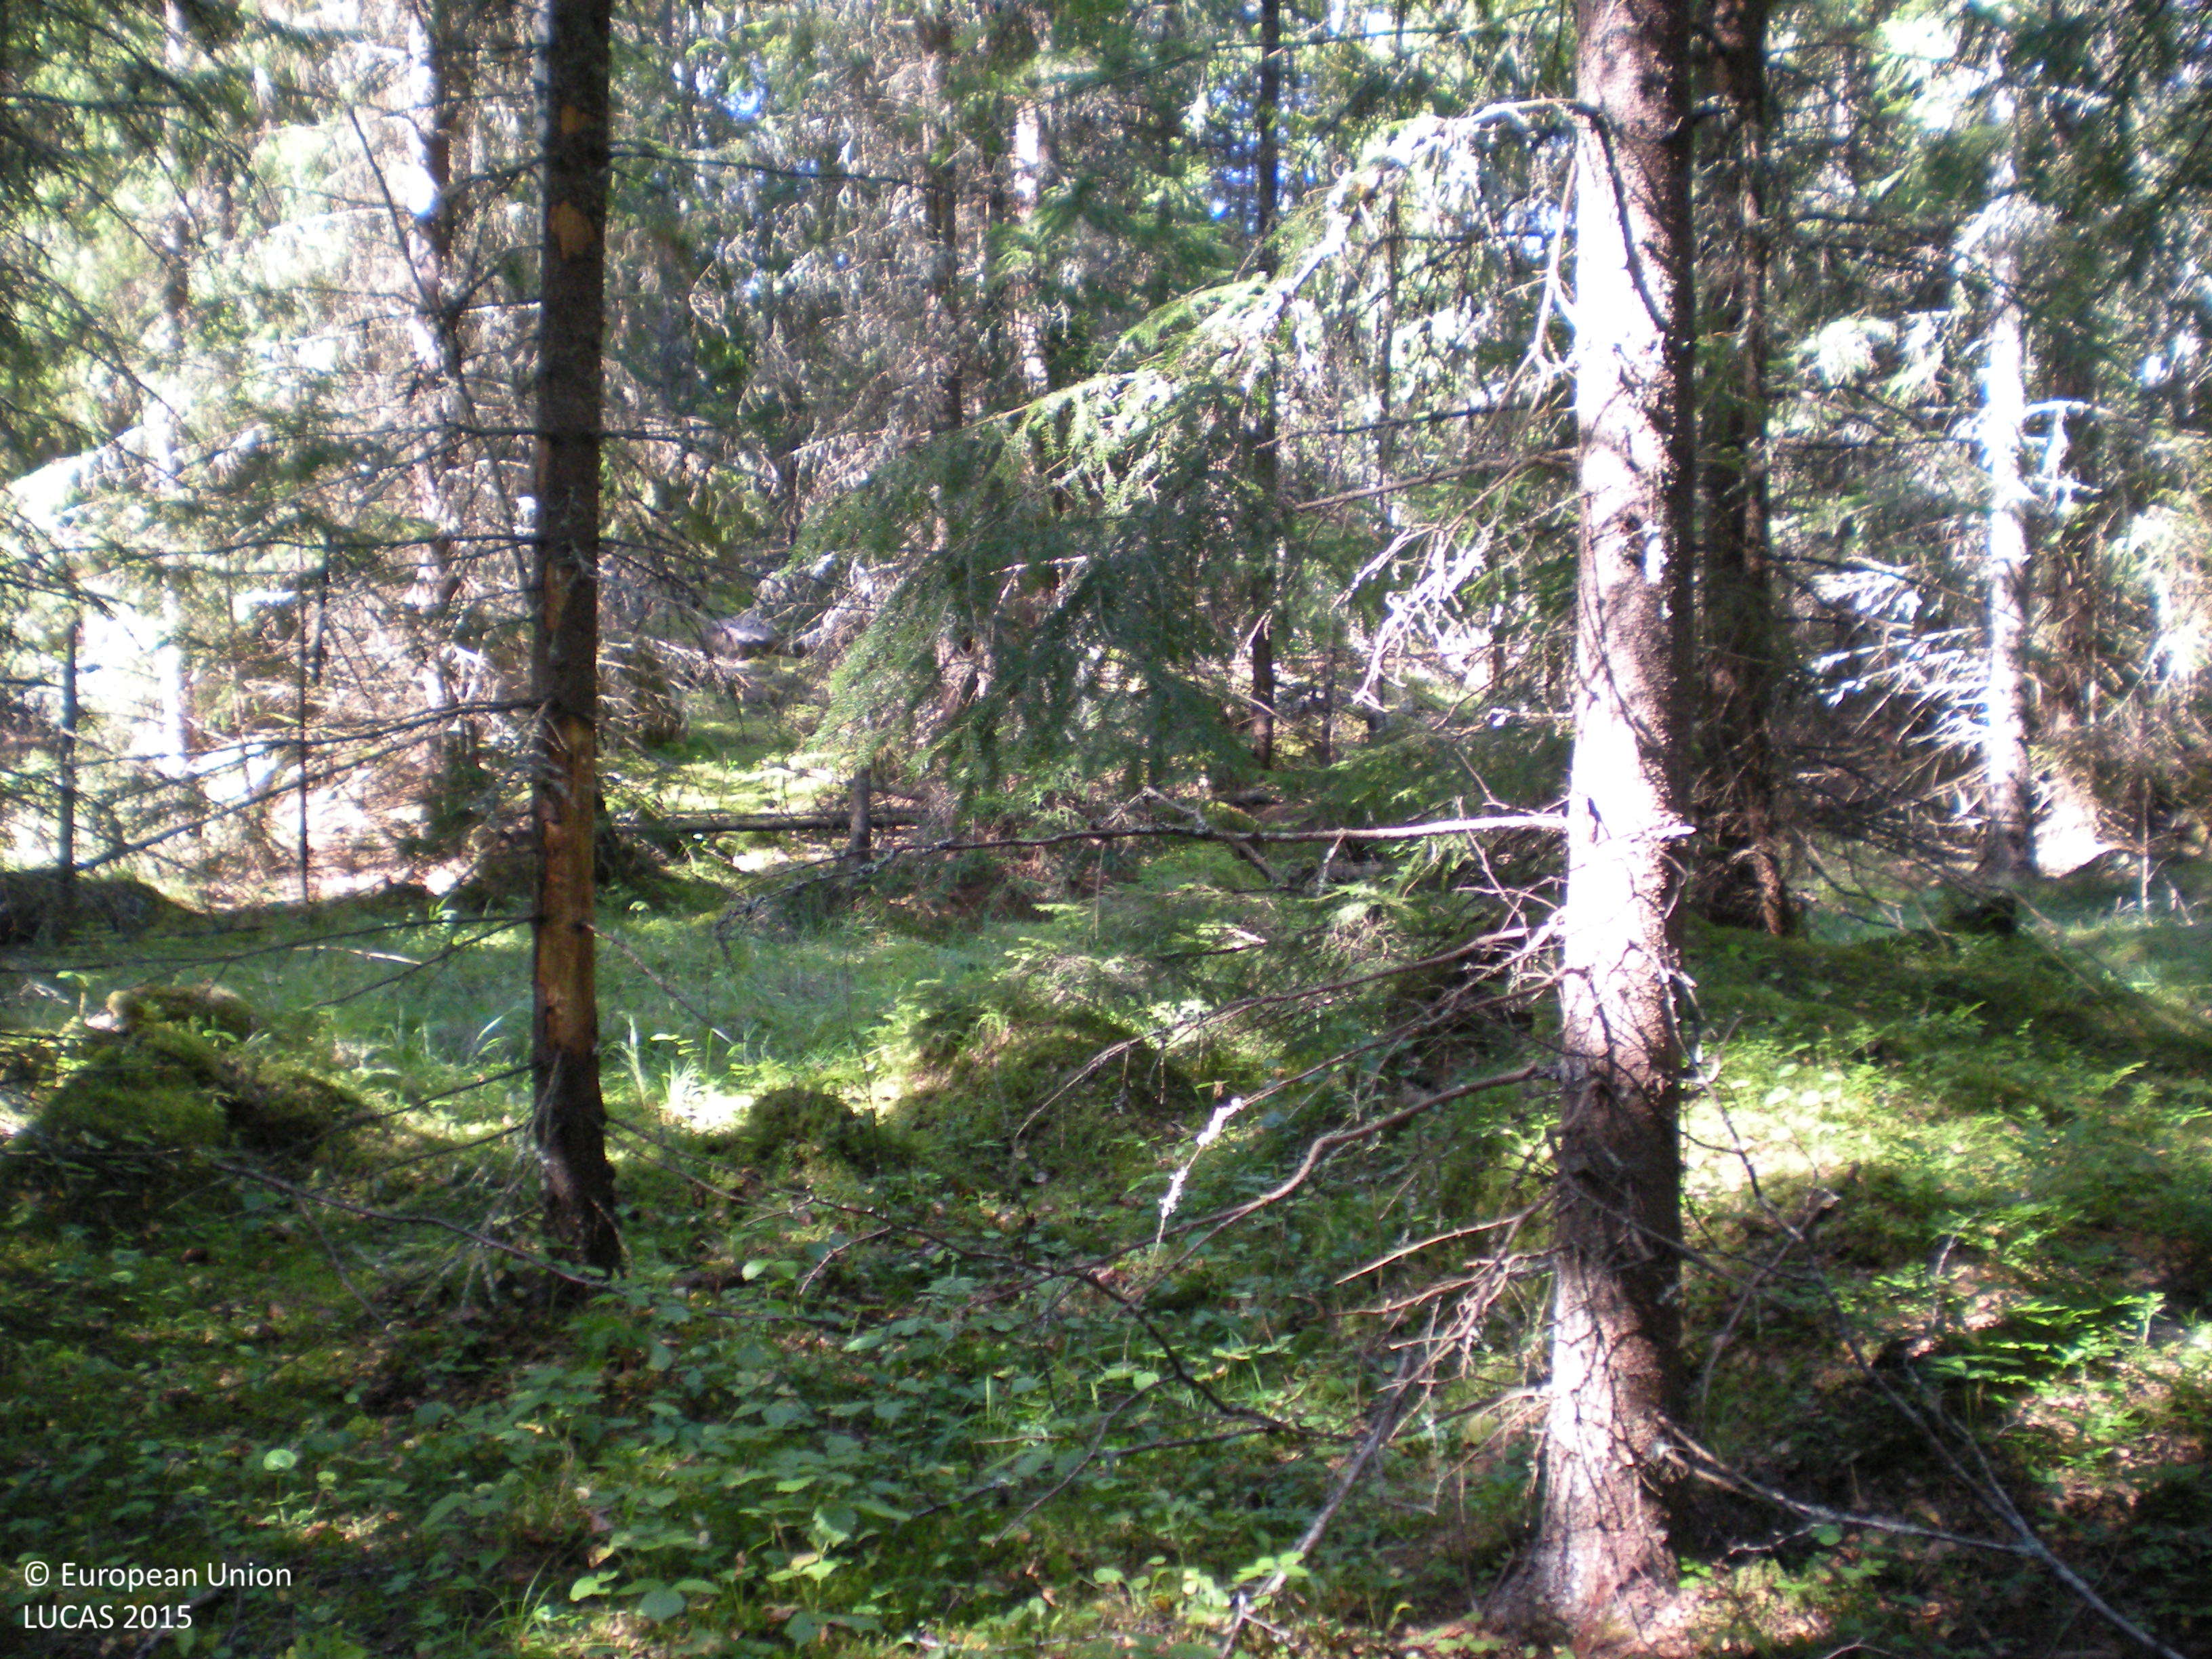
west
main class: Woodland
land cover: Spruce dominated coniferous woodland
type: boreal forest
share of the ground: > 75 %
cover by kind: coniferous forest trees 80 %, lichens and mosses 10 %, broadleaved forest trees 5 %, shrubs 5 %
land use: Forestry
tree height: > 5 m
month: August
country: SE
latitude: 60.6246
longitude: 17.6483
